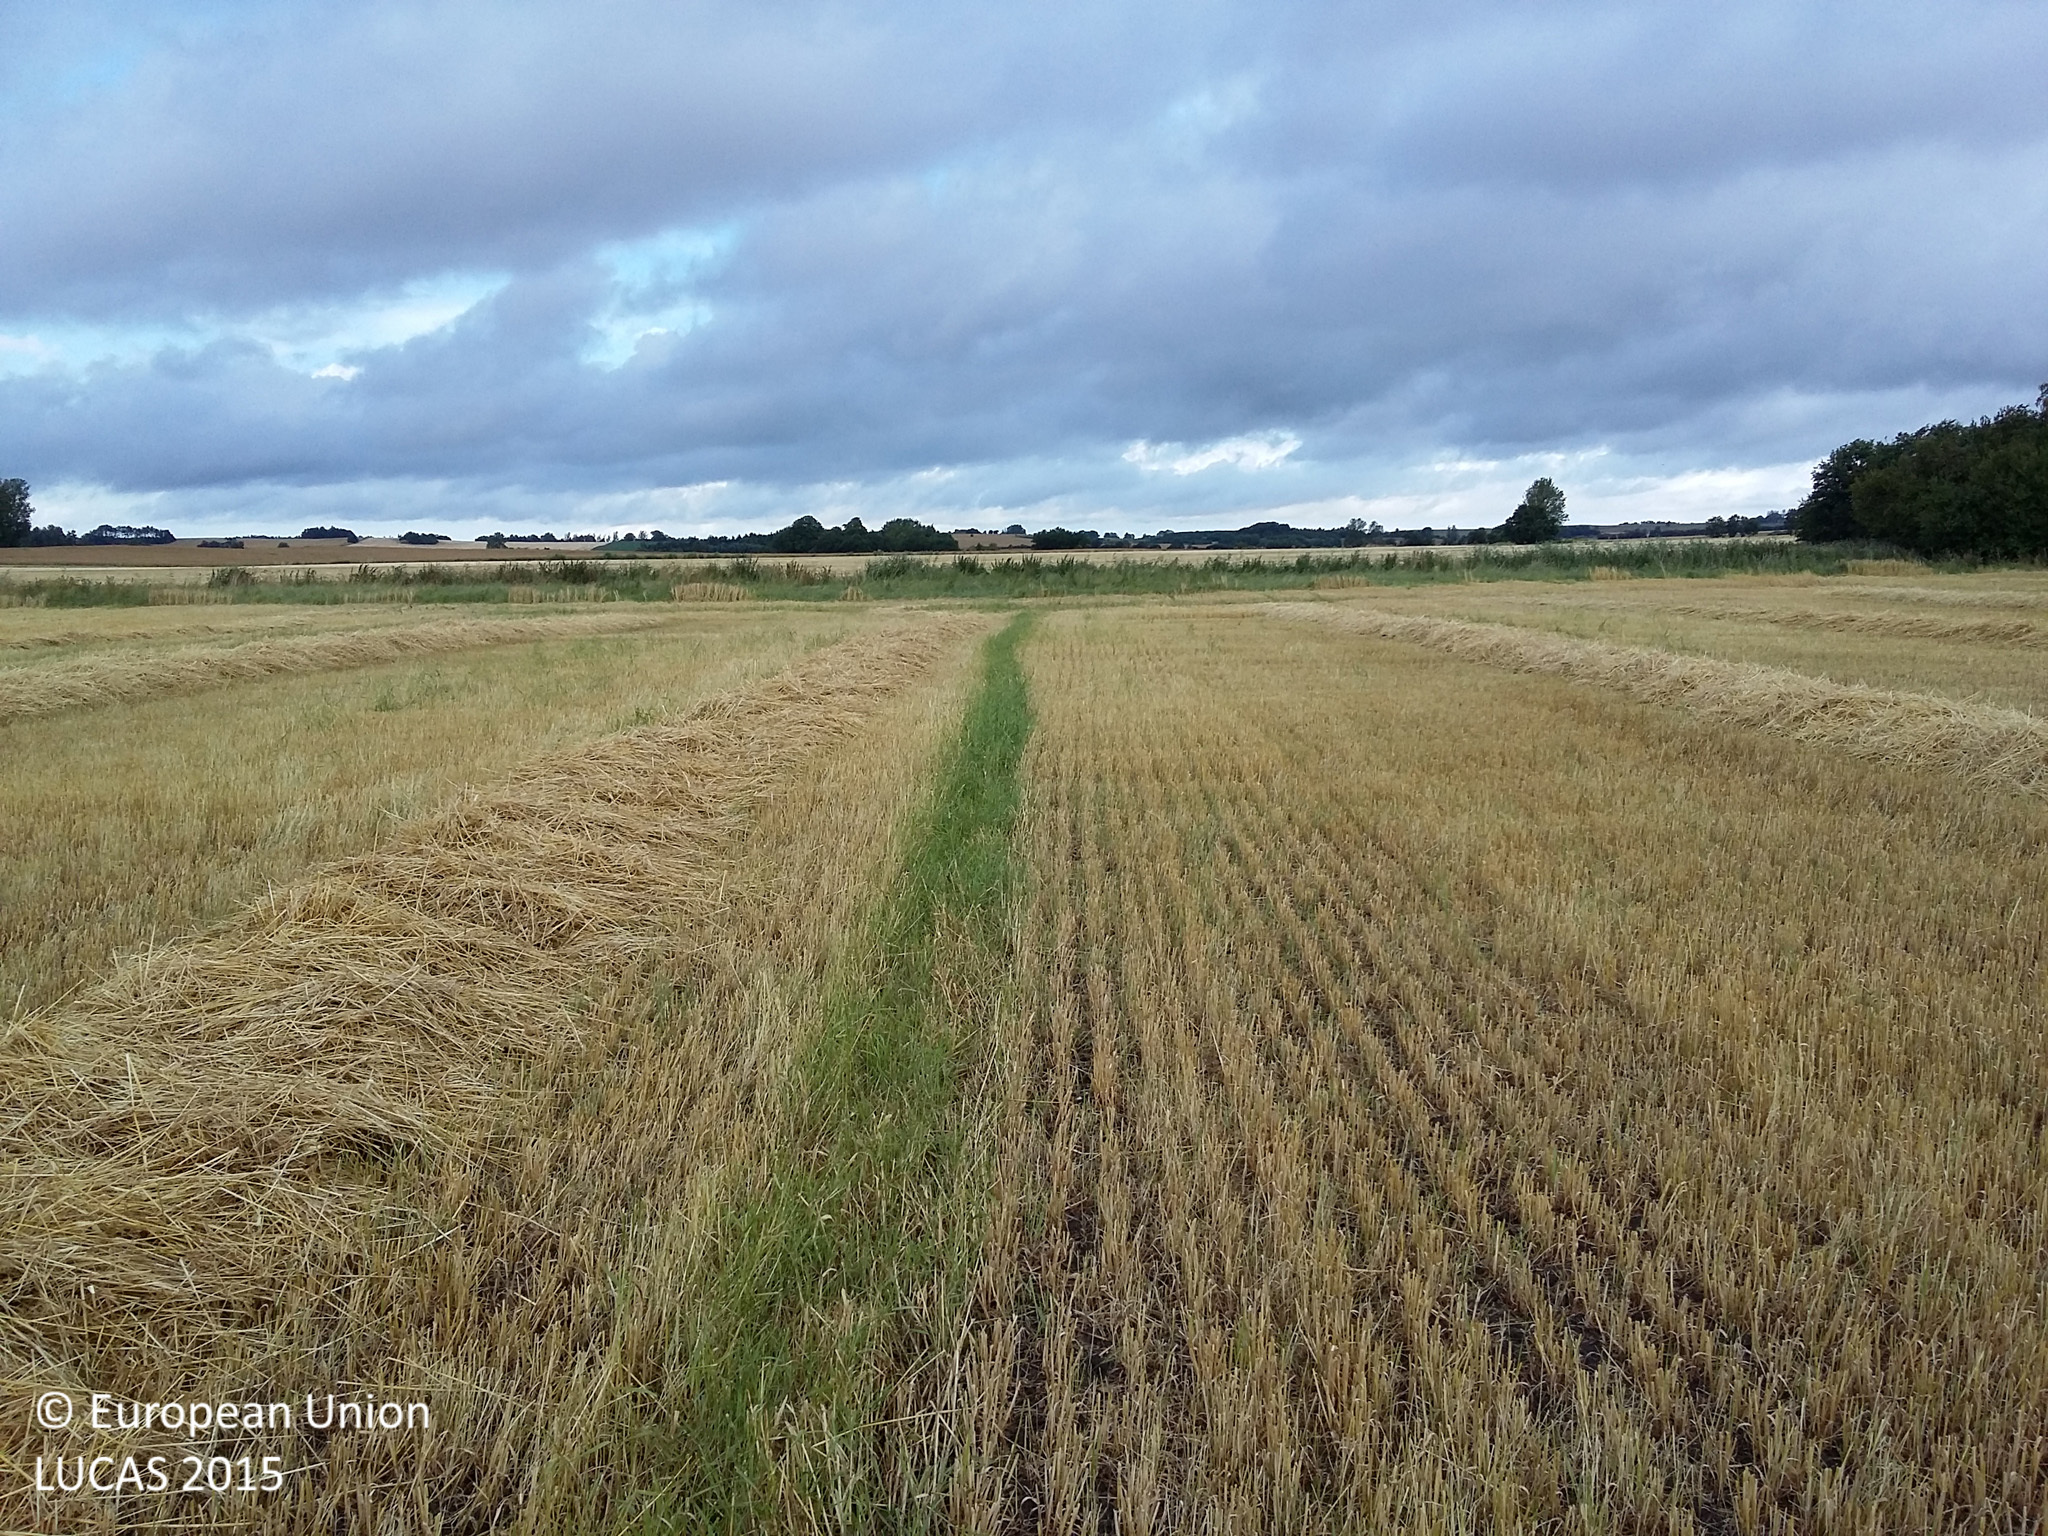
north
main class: Cropland
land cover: Barley
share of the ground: > 75 %
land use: Agriculture (excluding fallow land and kitchen gardens)
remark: Harvested field
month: July
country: DK
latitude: 55.8830
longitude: 12.0923
